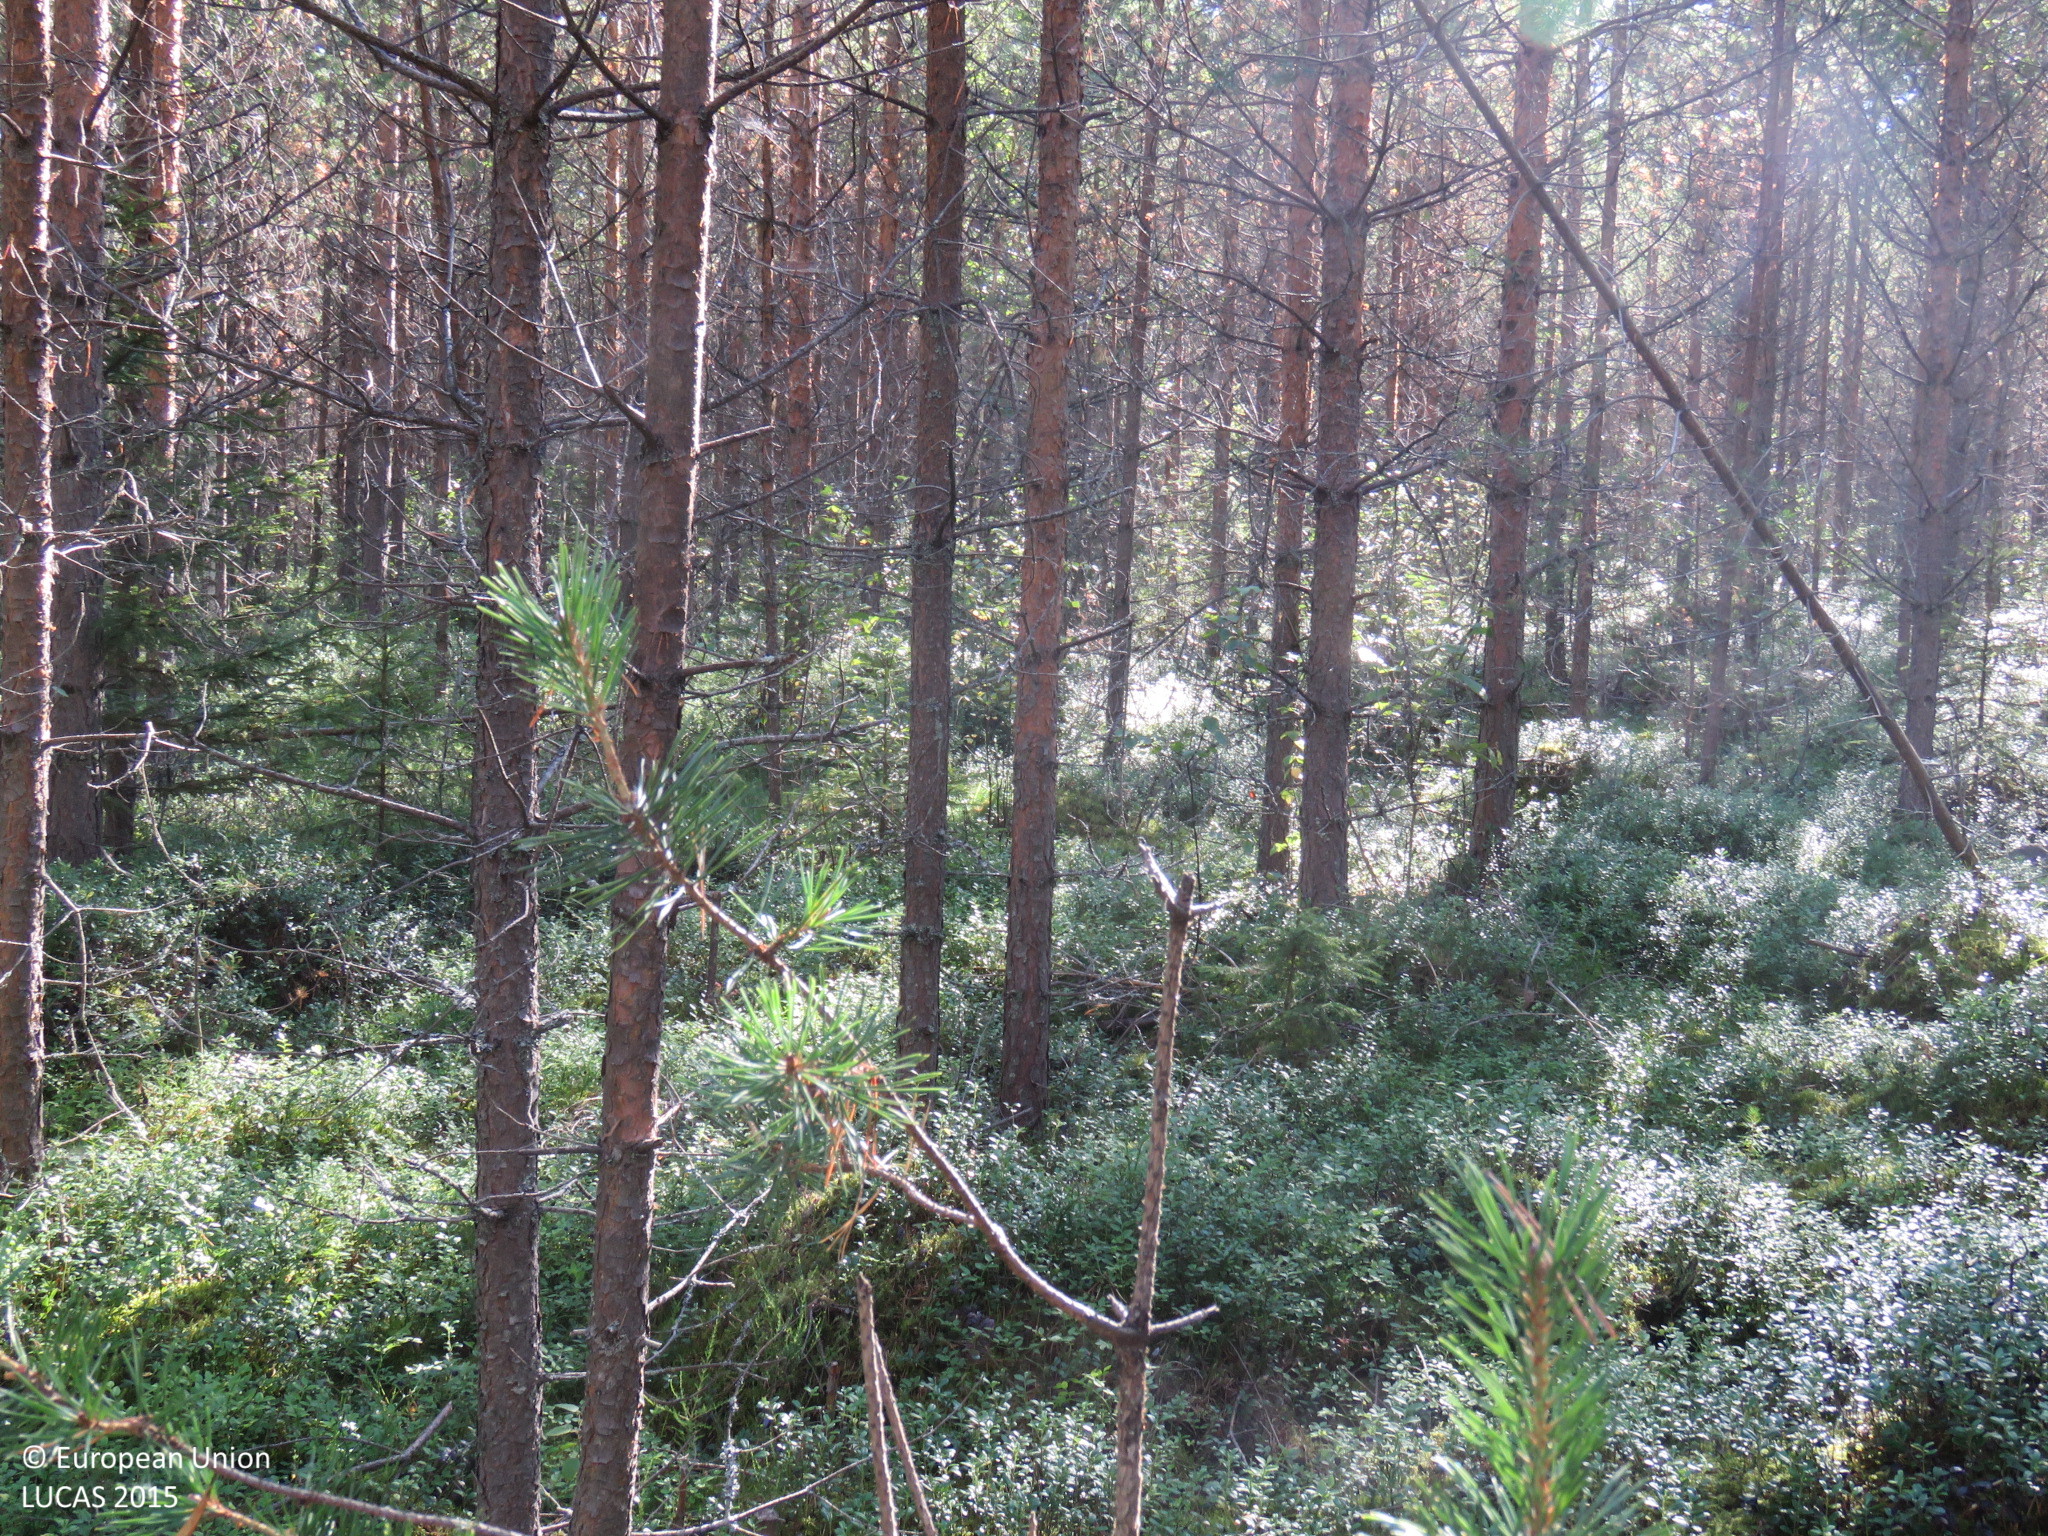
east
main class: Woodland
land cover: Pine dominated coniferous woodland
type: boreal forest
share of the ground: > 75 %
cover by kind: coniferous forest trees 85 %, broadleaved forest trees 5 %, shrubs 5 %, lichens and mosses 5 %
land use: Forestry
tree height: > 5 m
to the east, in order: Pine dominated coniferous woodland; Tracks; Pine dominated coniferous woodland; Pine dominated mixed woodland; Ditches and canals; Pine dominated mixed woodland; Pine dominated coniferous woodland; Ditches and canals; Pine dominated coniferous woodland
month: August
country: FI
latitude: 65.1560
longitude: 25.5916
